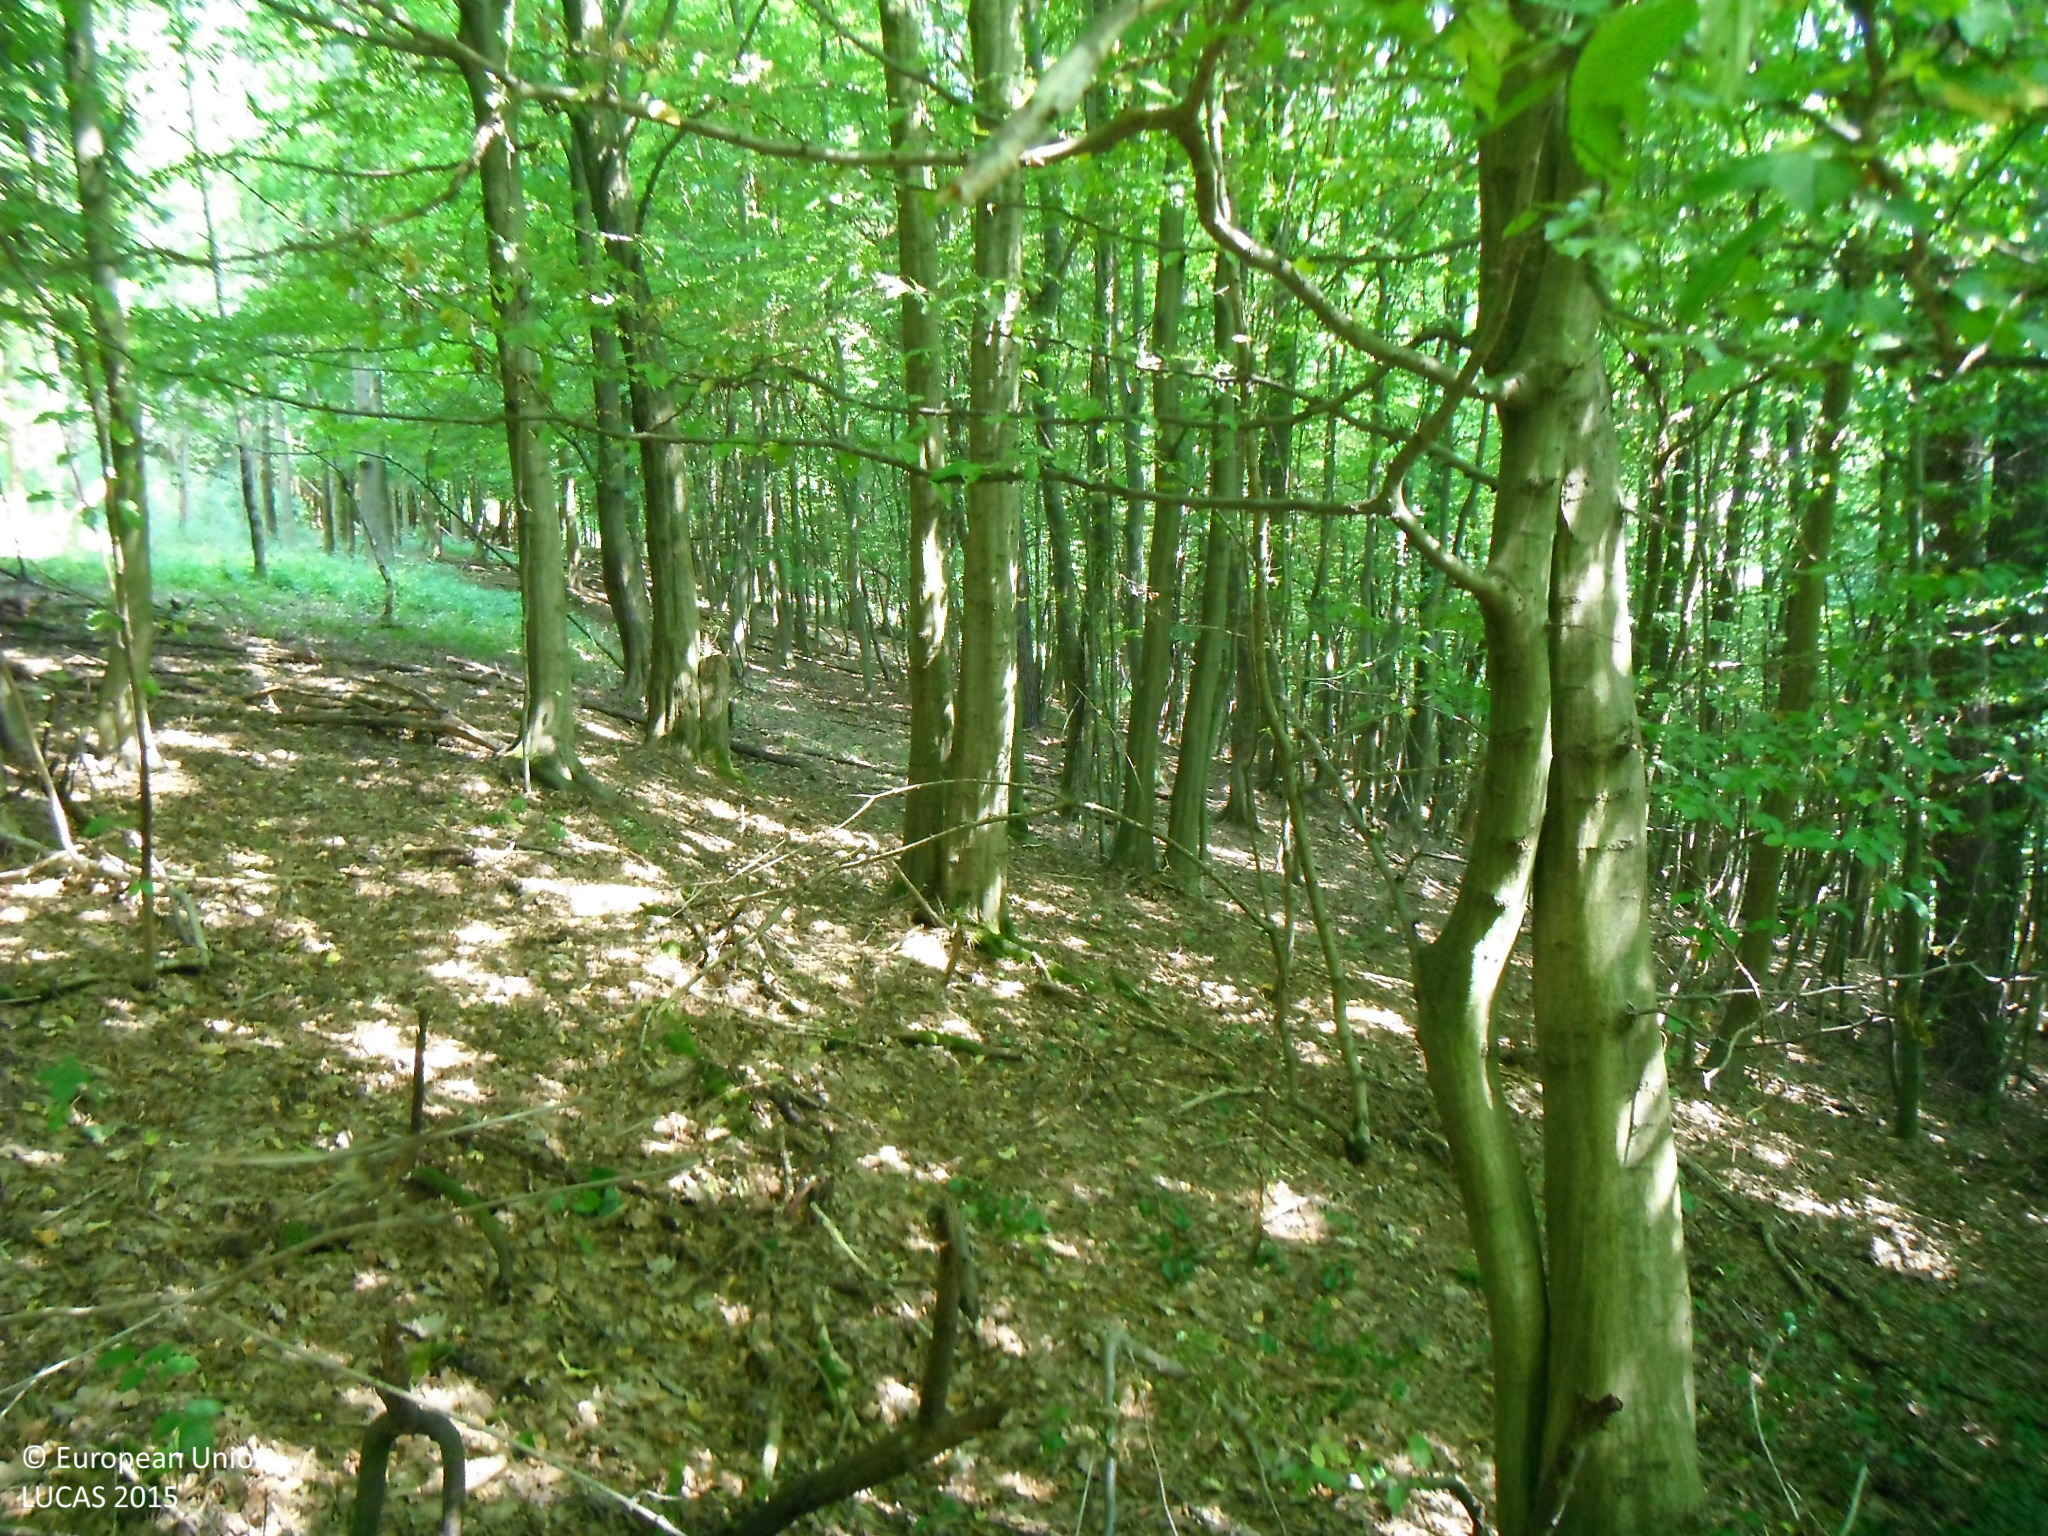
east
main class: Woodland
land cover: Pine dominated mixed woodland
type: mesophytic deciduous forest
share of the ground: > 75 %
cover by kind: broadleaved forest trees 70 %, coniferous forest trees 30 %
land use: Forestry
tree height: > 5 m
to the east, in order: Pine dominated mixed woodland; Tracks; Pine dominated mixed woodland; Broadleaved woodland; Tracks; Pine dominated mixed woodland
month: August
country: SK
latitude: 49.1989
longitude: 18.2367
